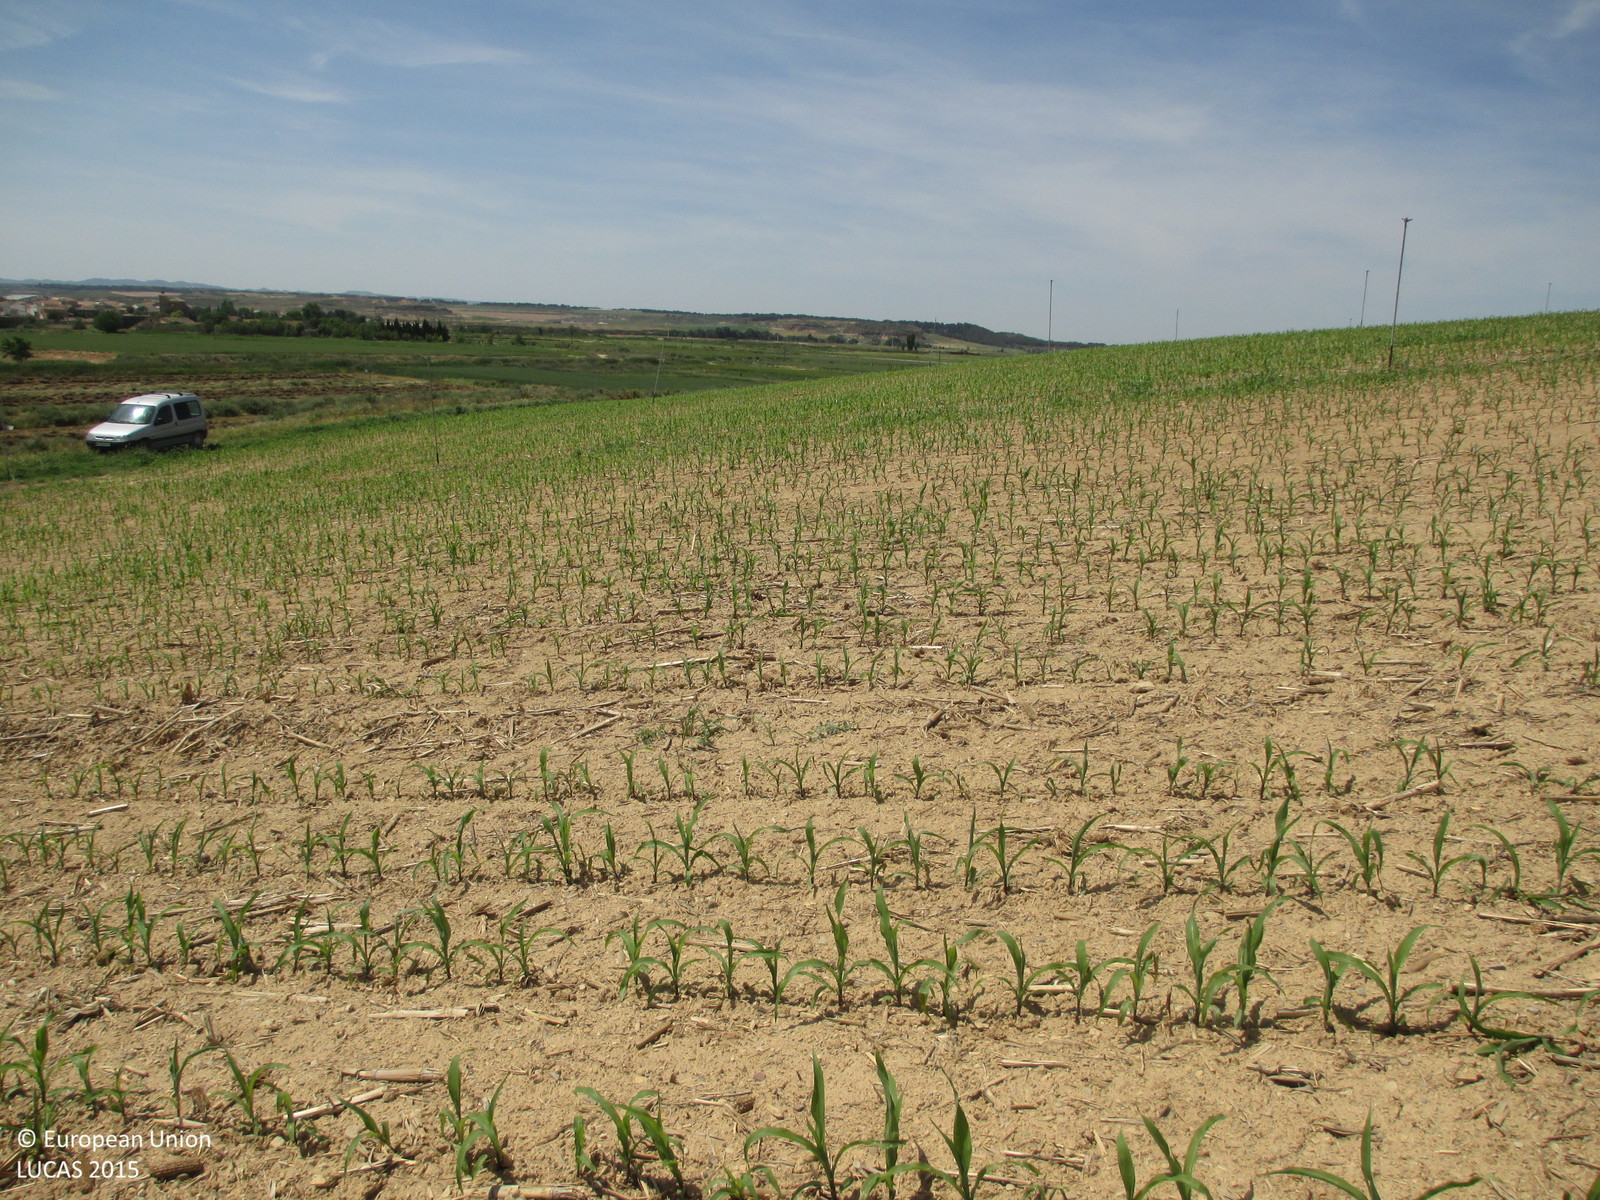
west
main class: Cropland
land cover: Maize
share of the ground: 10 - 25 %
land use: Agriculture (excluding fallow land and kitchen gardens)
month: May
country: ES
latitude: 41.8731
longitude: -0.2973
